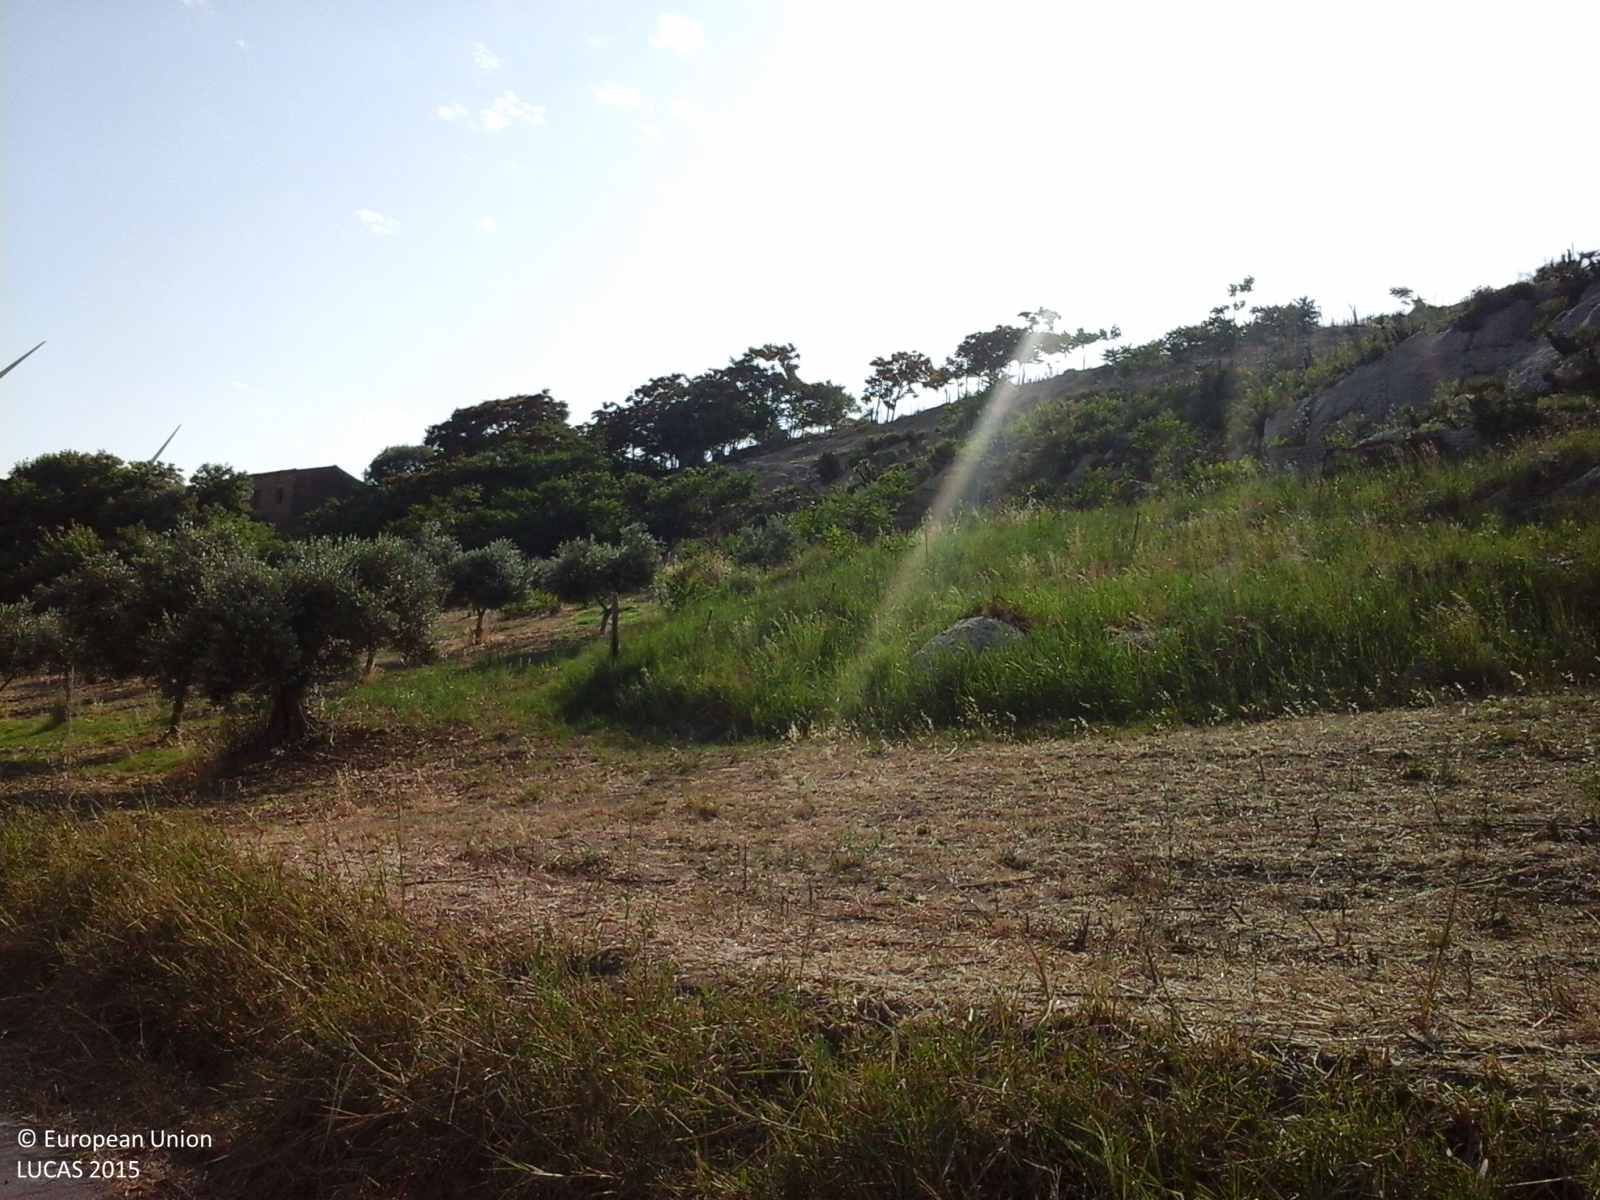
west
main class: Grassland
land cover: Grassland without tree/shrub cover
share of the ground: > 75 %
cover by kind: herbaceous plants 100 %
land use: Agriculture (excluding fallow land and kitchen gardens)
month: June
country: IT
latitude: 37.7775
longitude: 12.8513
